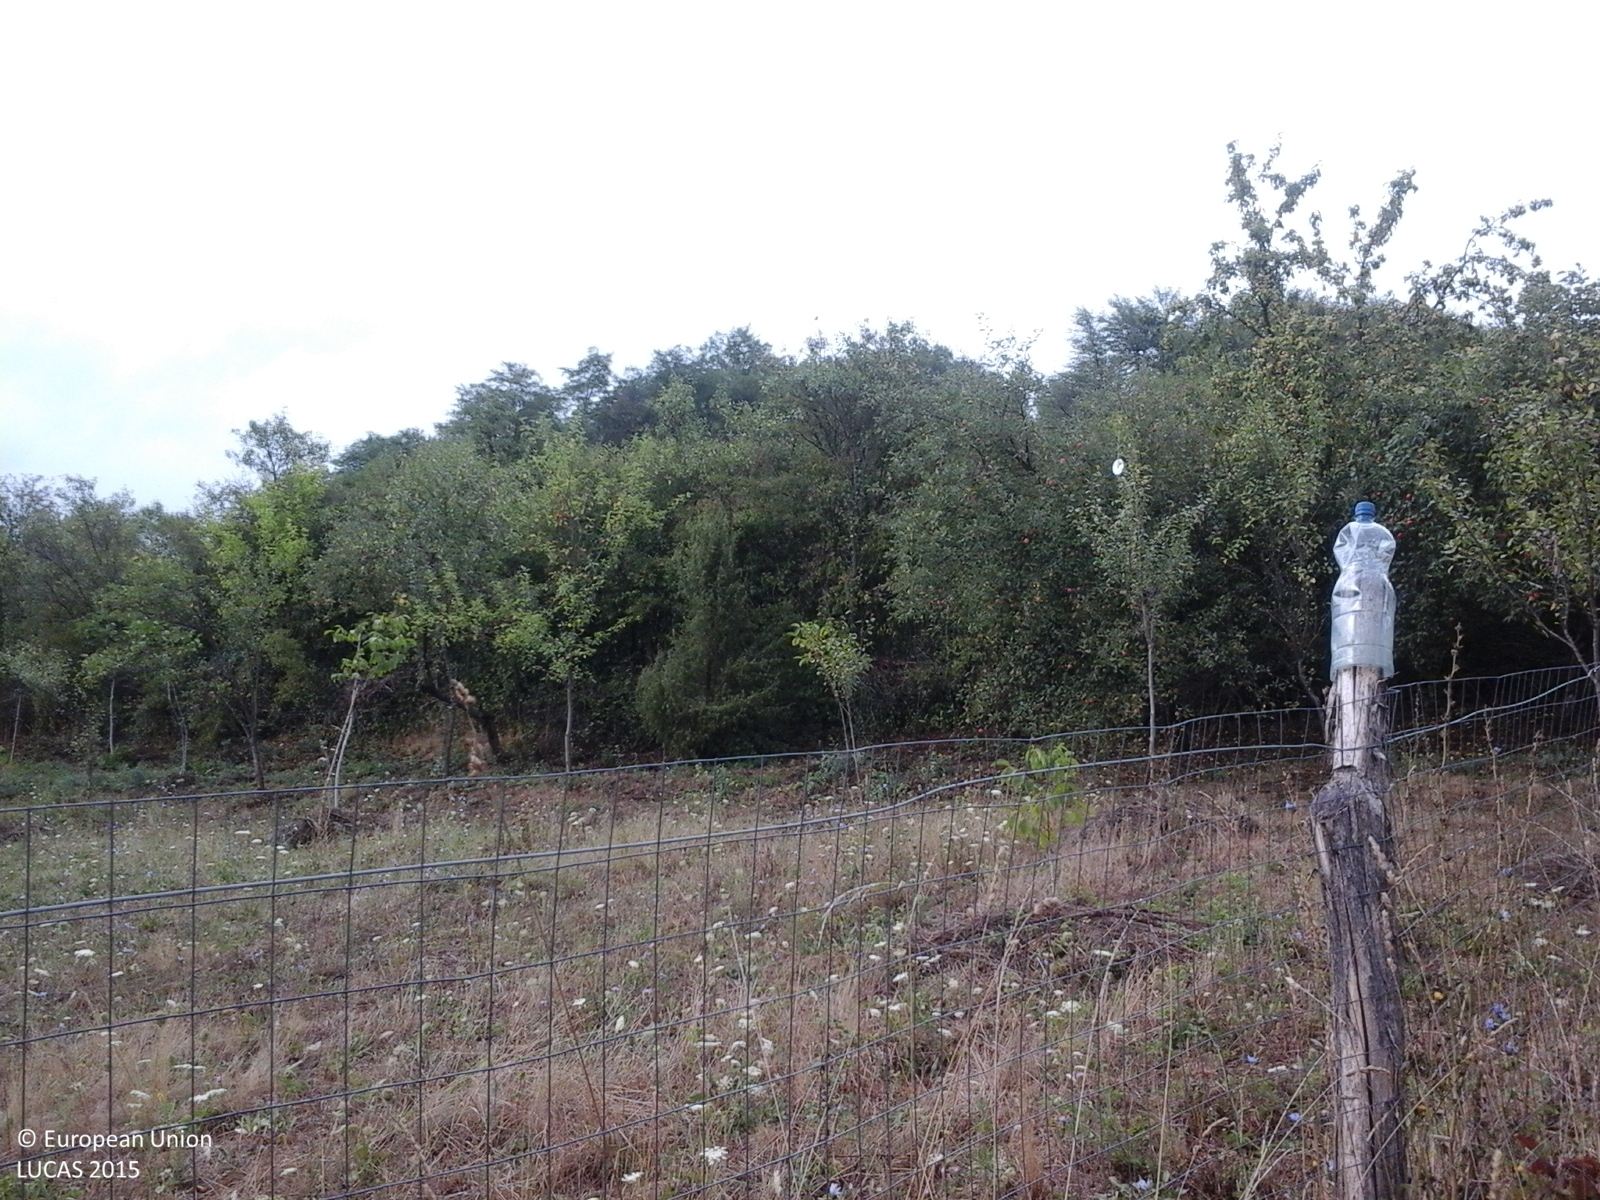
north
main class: Cropland
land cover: Nuts trees
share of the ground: 25 - 50 %
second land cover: Grassland without tree/shrub cover
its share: > 75 %
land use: Agriculture (excluding fallow land and kitchen gardens)
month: August
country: RO
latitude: 44.8959
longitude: 21.9498
